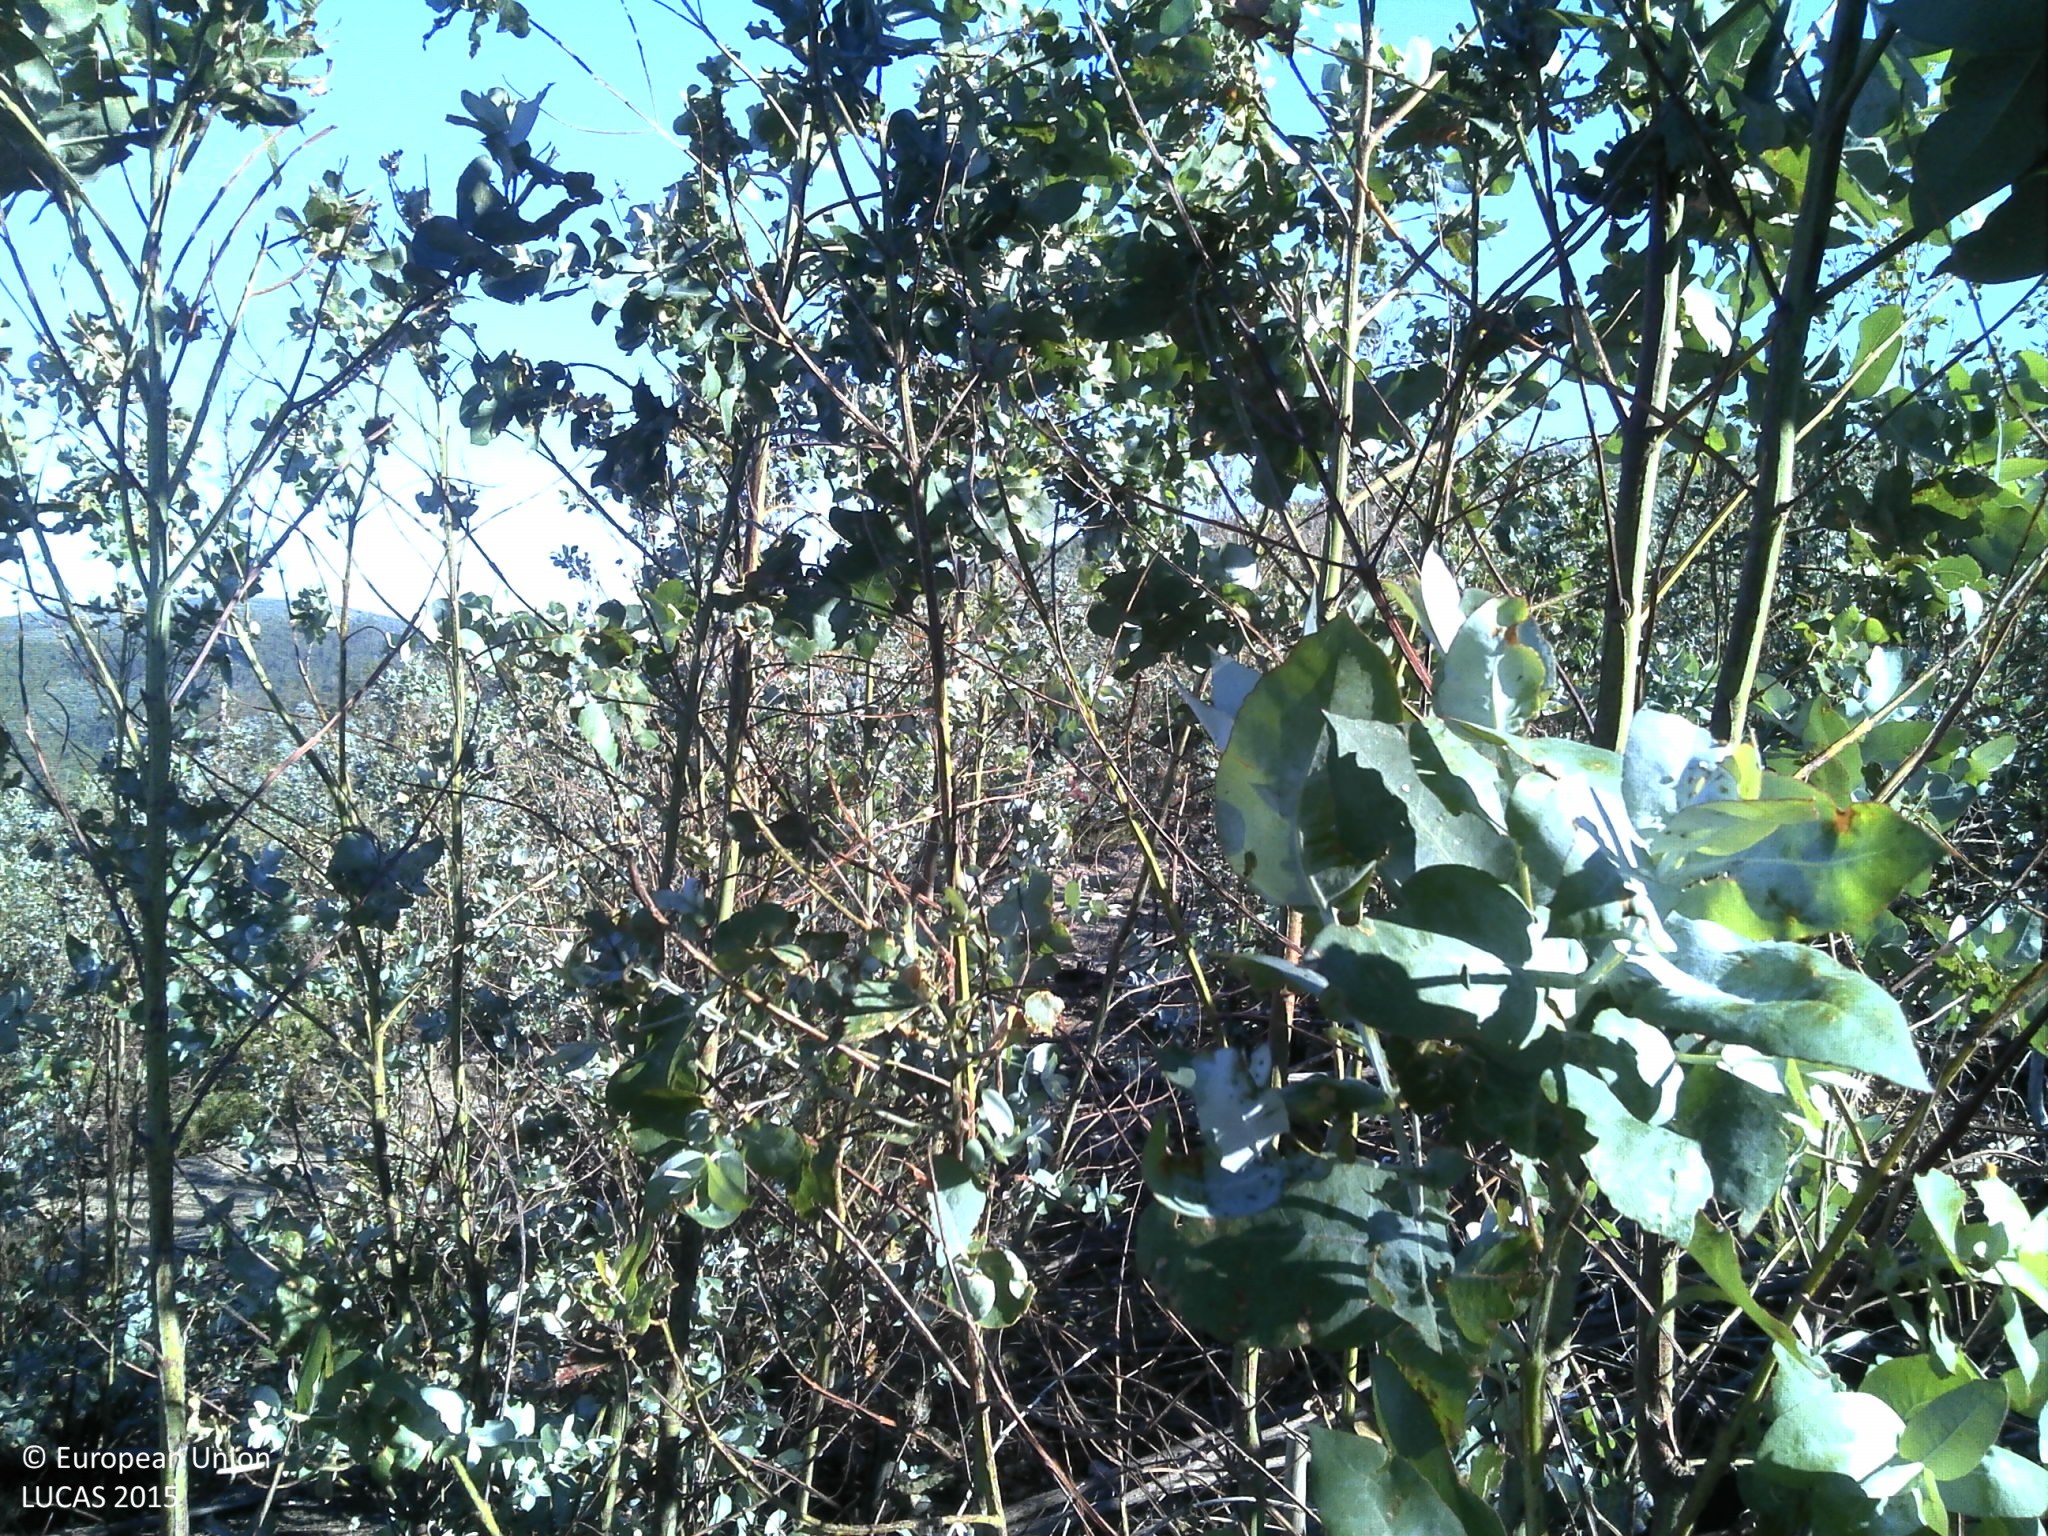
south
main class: Woodland
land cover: Broadleaved woodland
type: exotic forest
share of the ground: 25 - 50 %
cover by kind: unconsolidated bare surface 65 %, broadleaved forest trees 25 %, shrubs 10 %
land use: Forestry
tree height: < 5 m
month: June
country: PT
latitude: 40.5483
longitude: -8.2818
